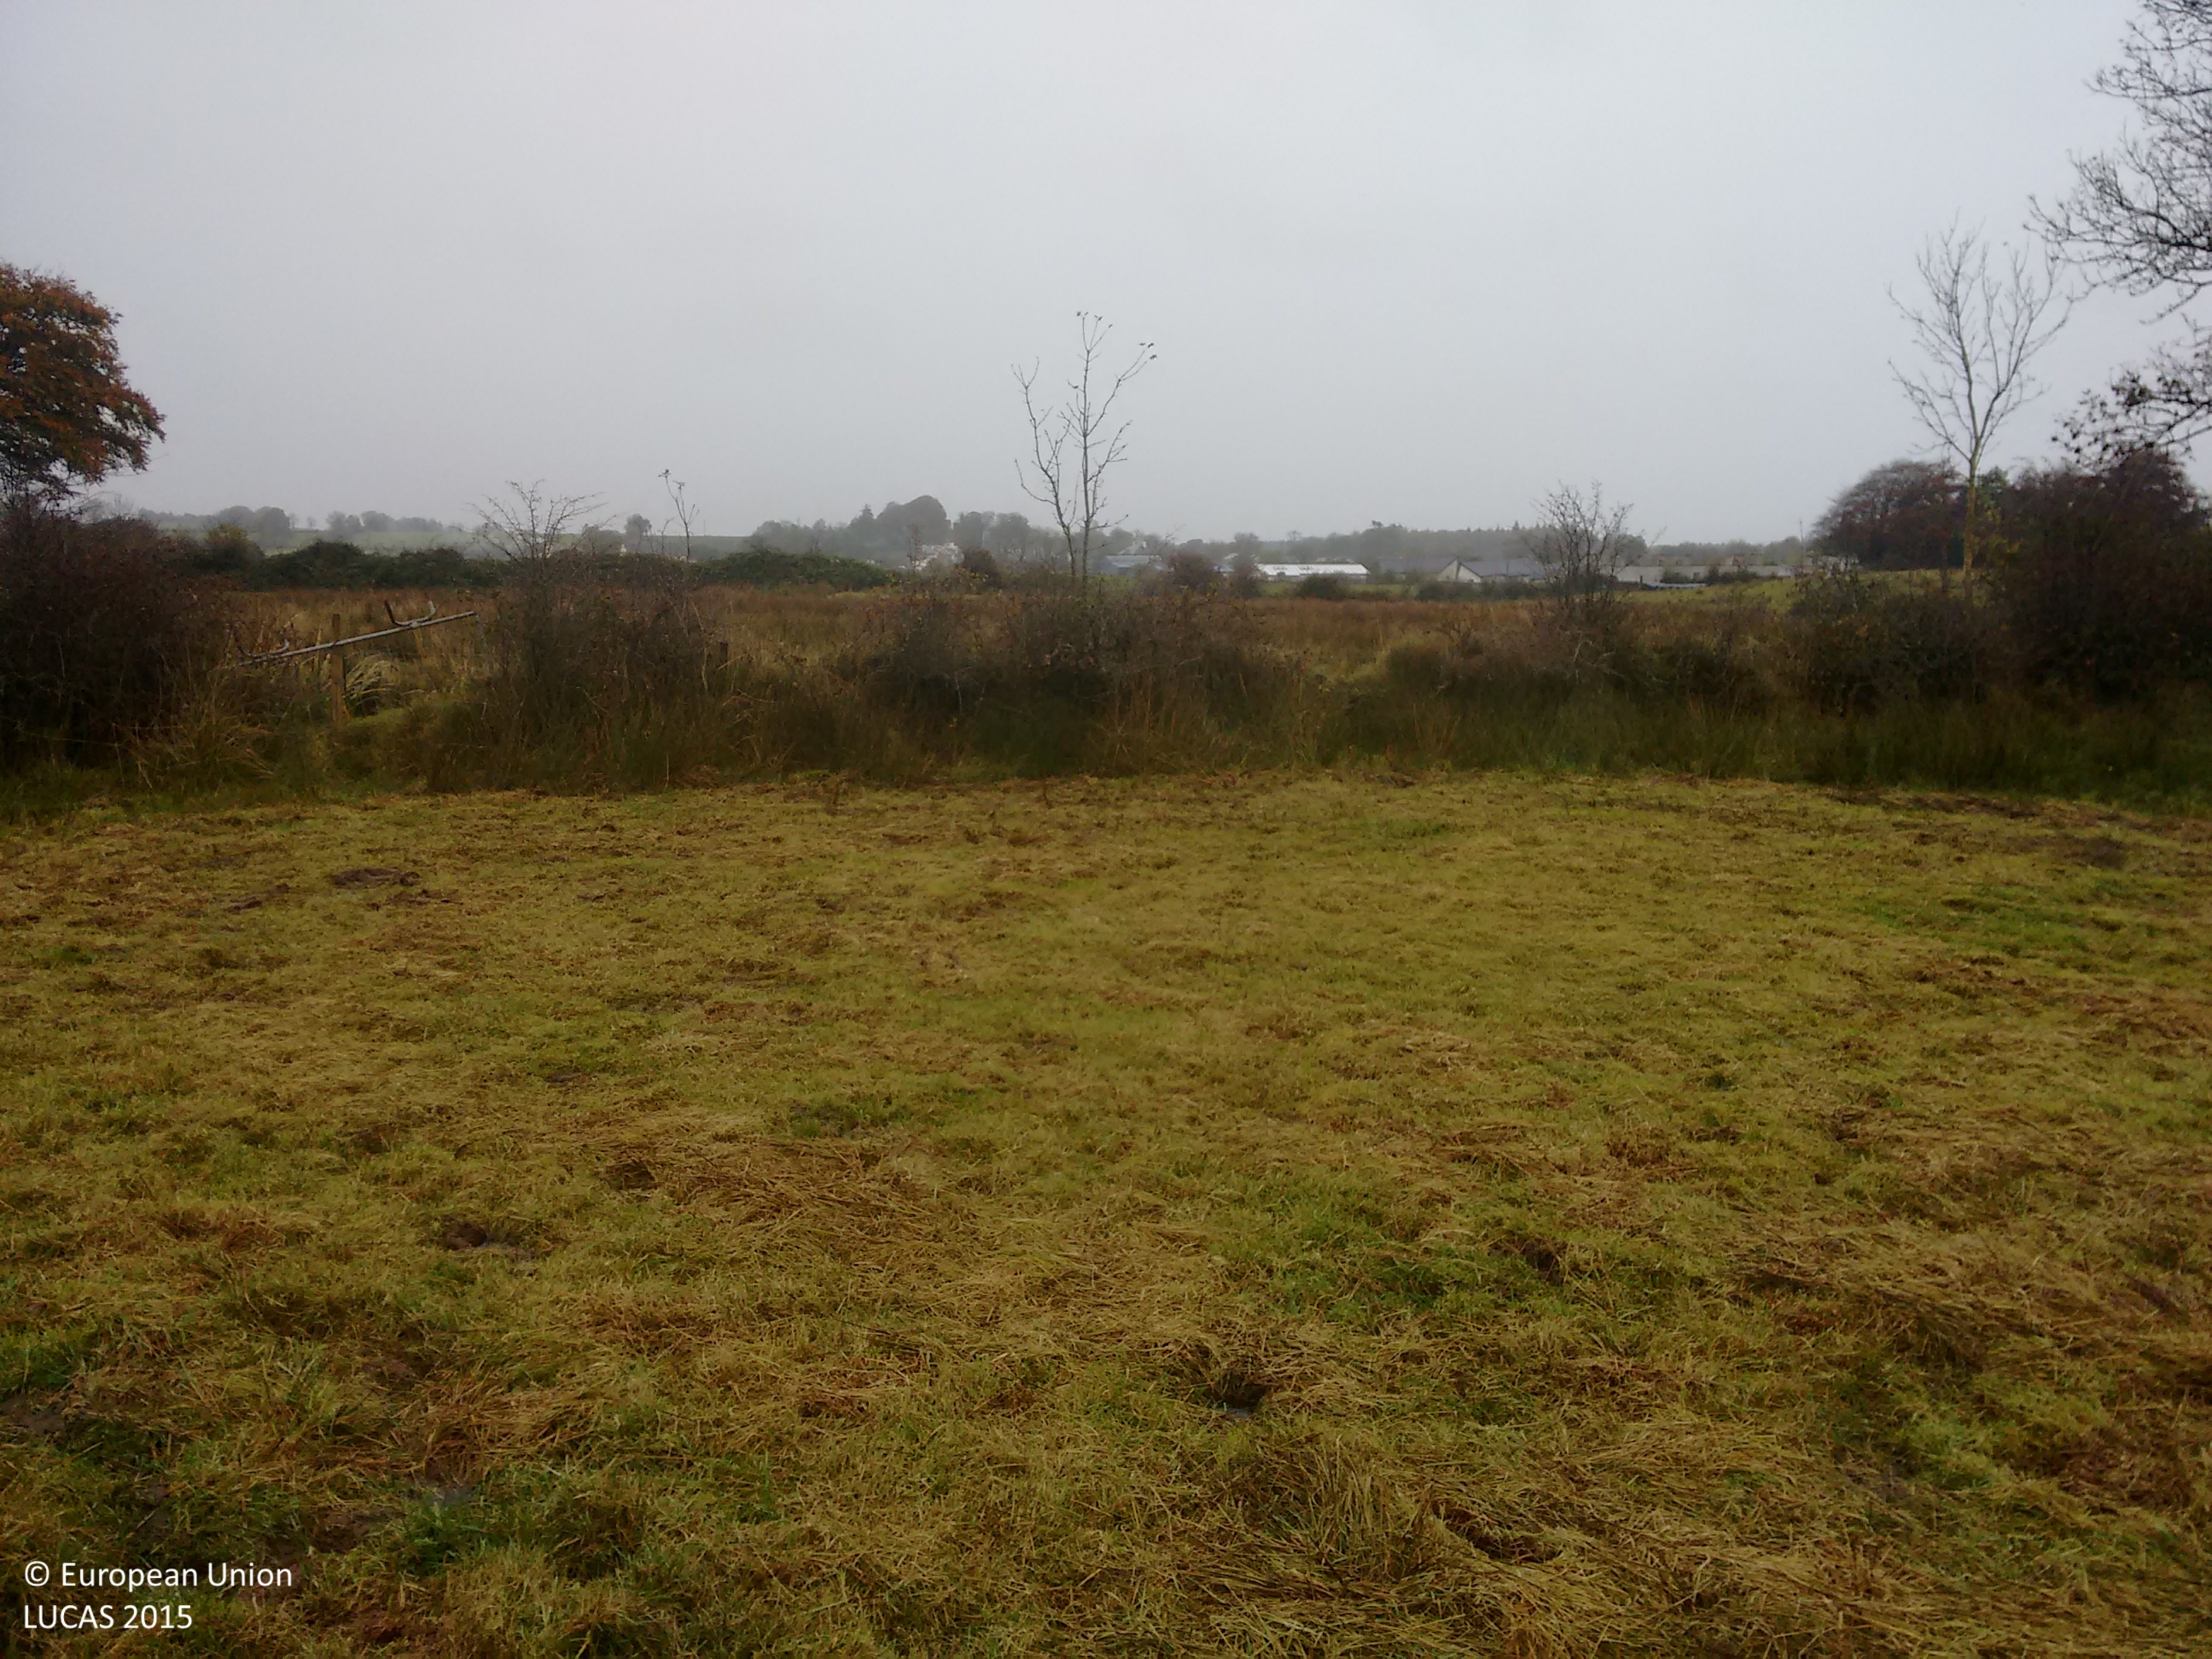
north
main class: Grassland
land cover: Grassland without tree/shrub cover
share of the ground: > 75 %
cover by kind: herbaceous plants 100 %
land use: Agriculture (excluding fallow land and kitchen gardens)
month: October
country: IE
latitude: 53.9045
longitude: -8.2189
